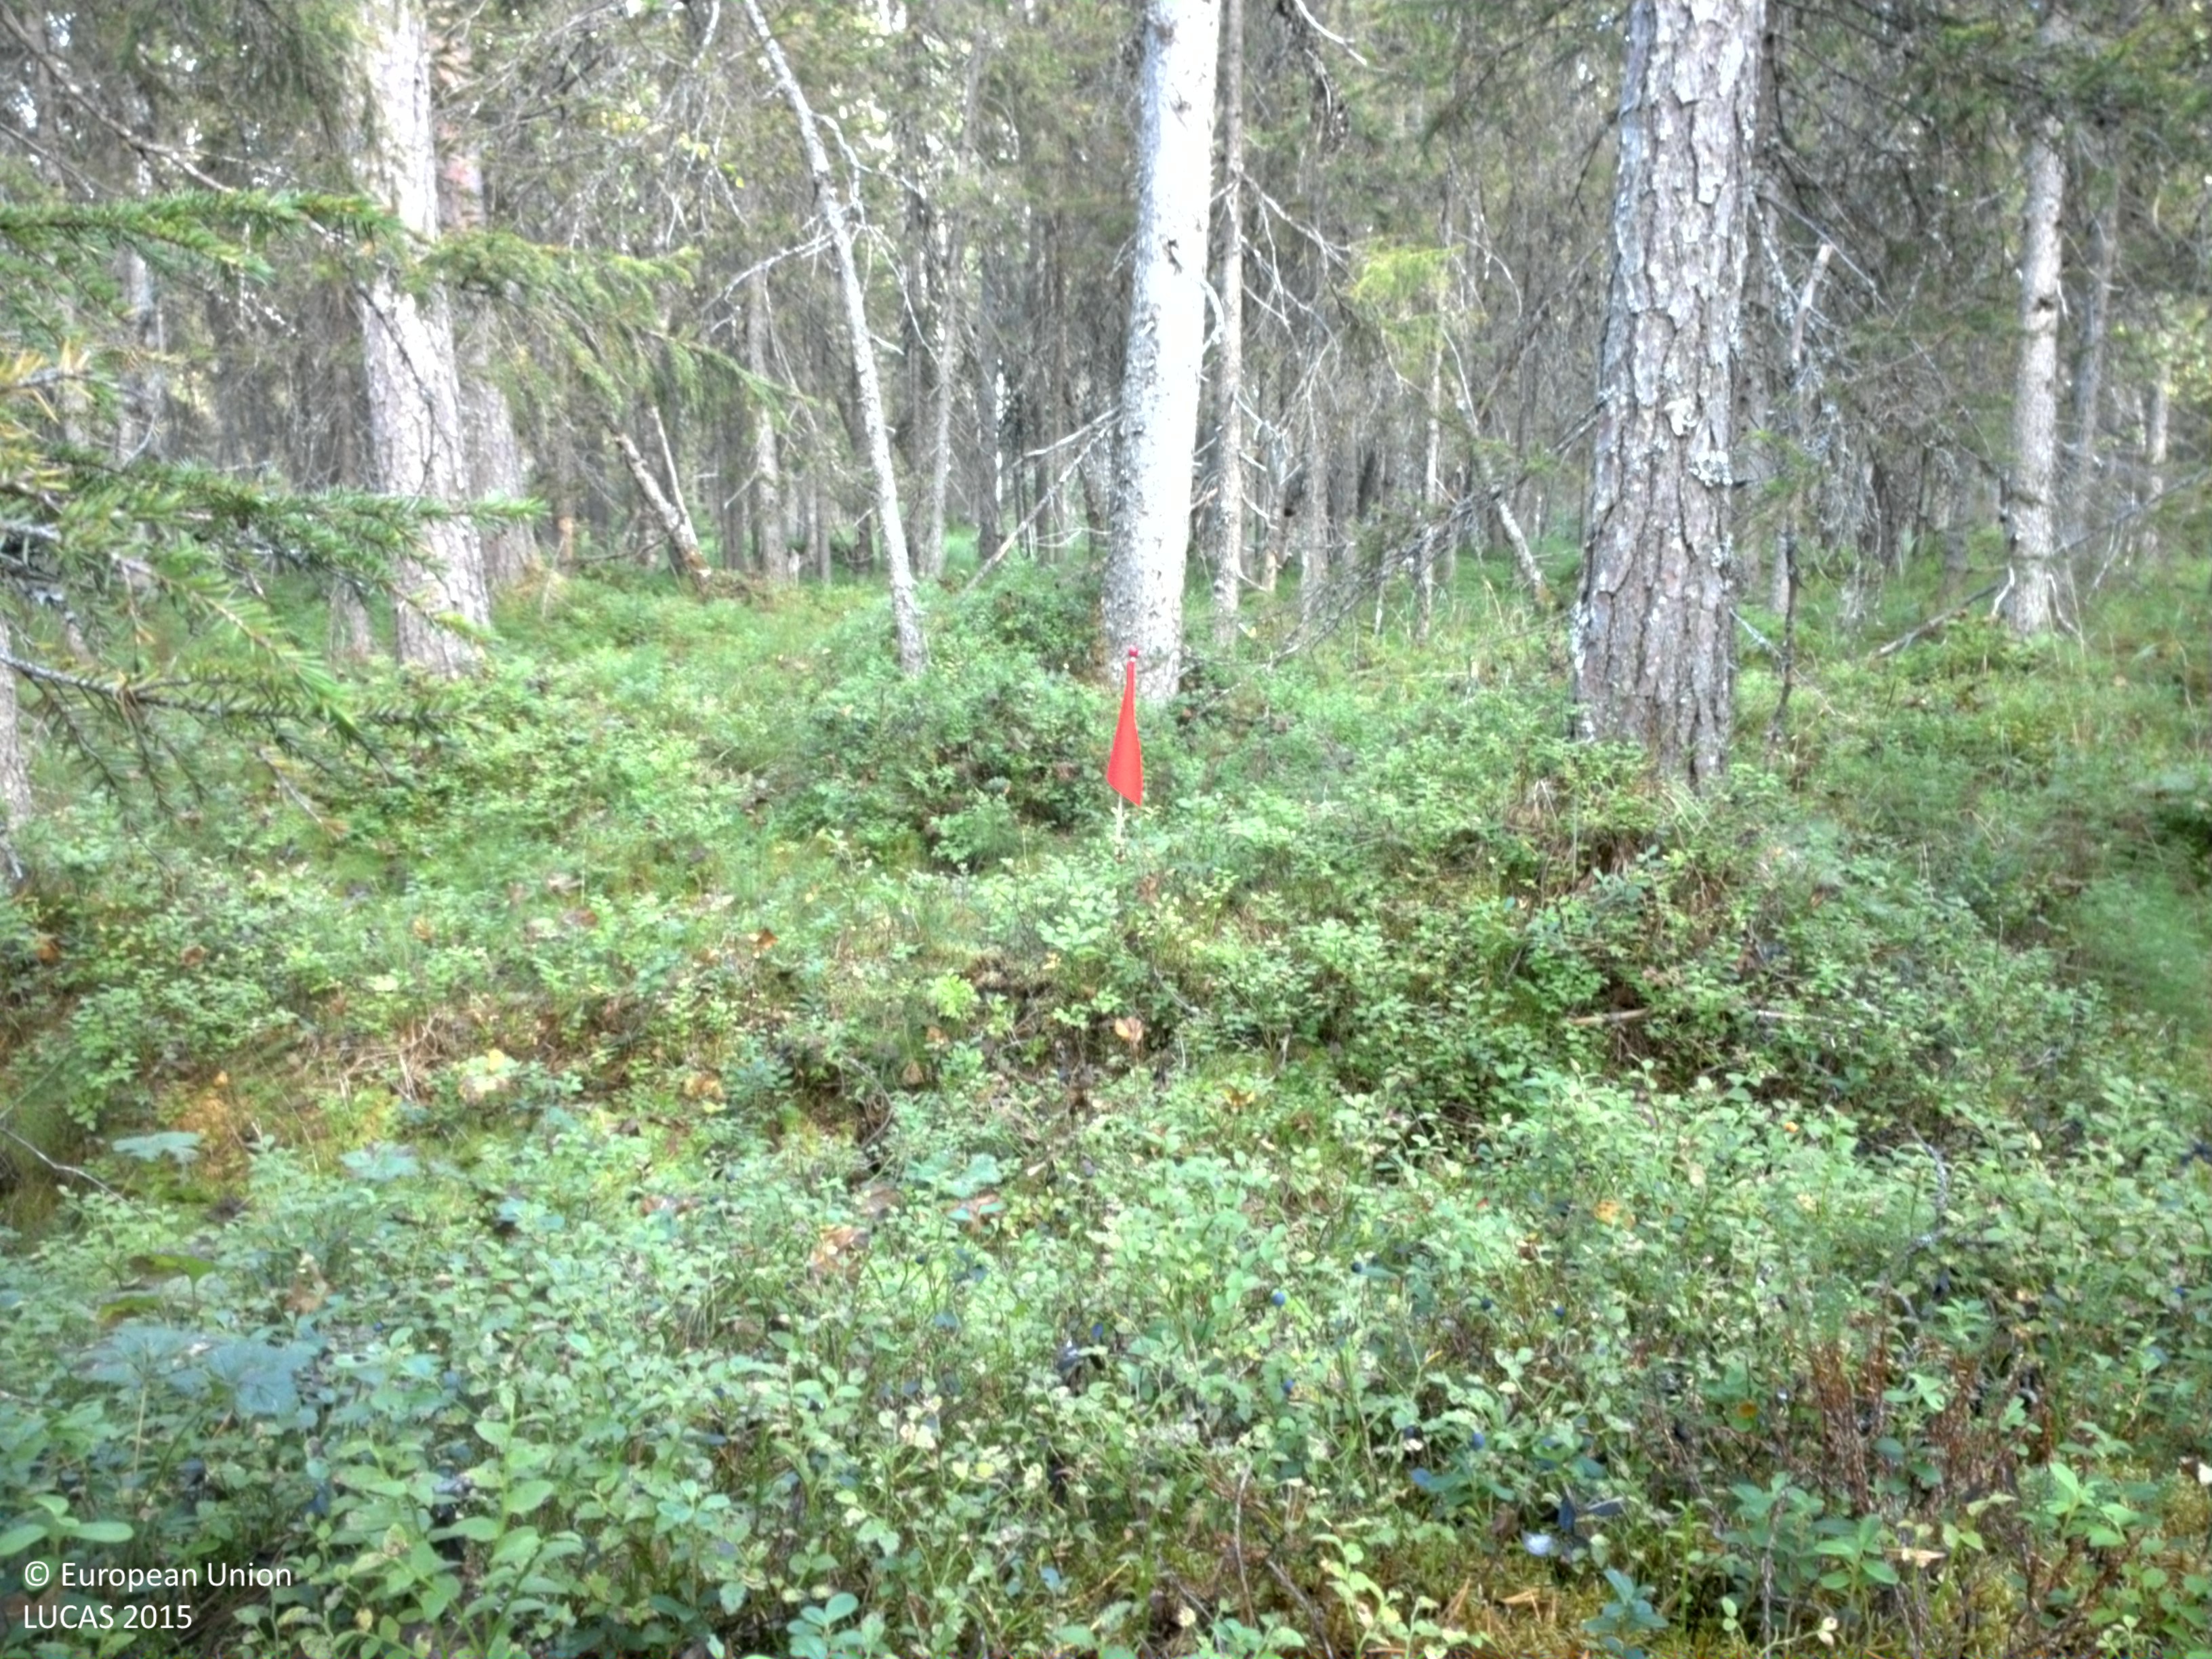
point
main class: Woodland
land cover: Spruce dominated coniferous woodland
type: boreal forest
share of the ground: 50 - 75 %
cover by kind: shrubs 45 %, coniferous forest trees 40 %, broadleaved forest trees 10 %, lichens and mosses 5 %
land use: Forestry
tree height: > 5 m
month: September
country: SE
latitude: 66.1335
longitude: 23.0735
